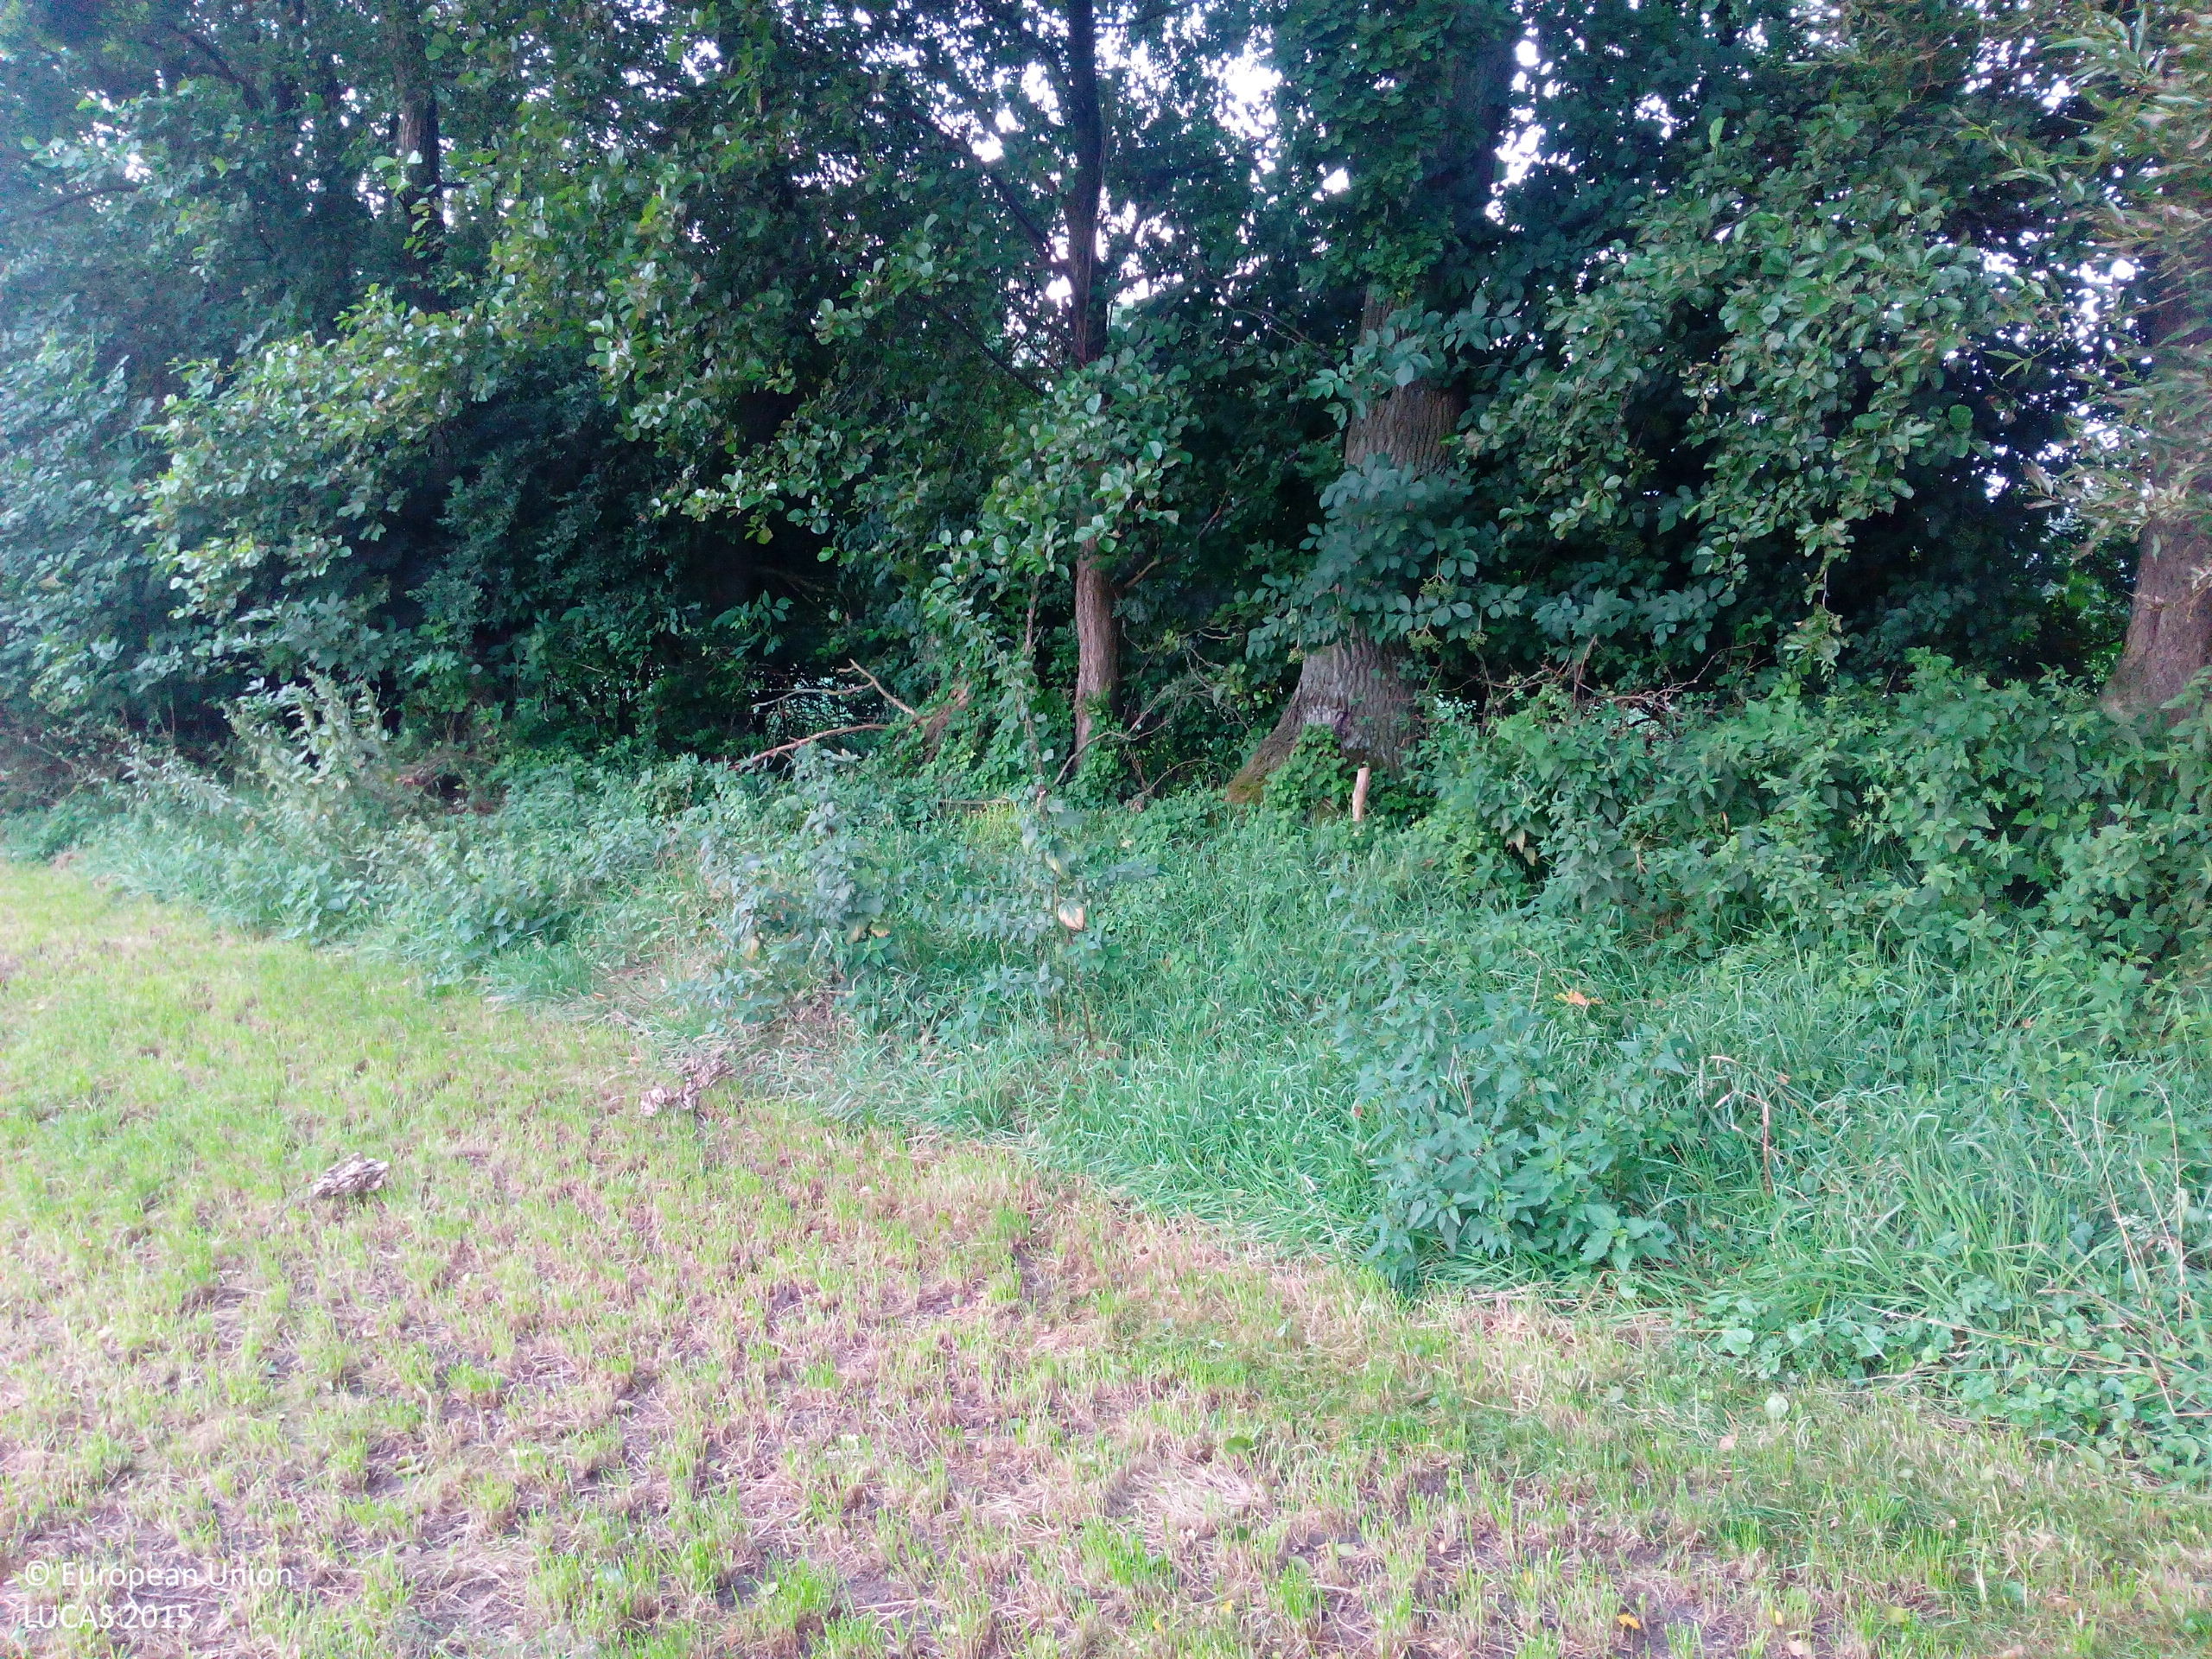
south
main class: Grassland
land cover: Grassland without tree/shrub cover
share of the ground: > 75 %
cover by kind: herbaceous plants 80 %, unconsolidated bare surface 20 %
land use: Agriculture (excluding fallow land and kitchen gardens)
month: August
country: DE
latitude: 53.8692
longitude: 9.9240
